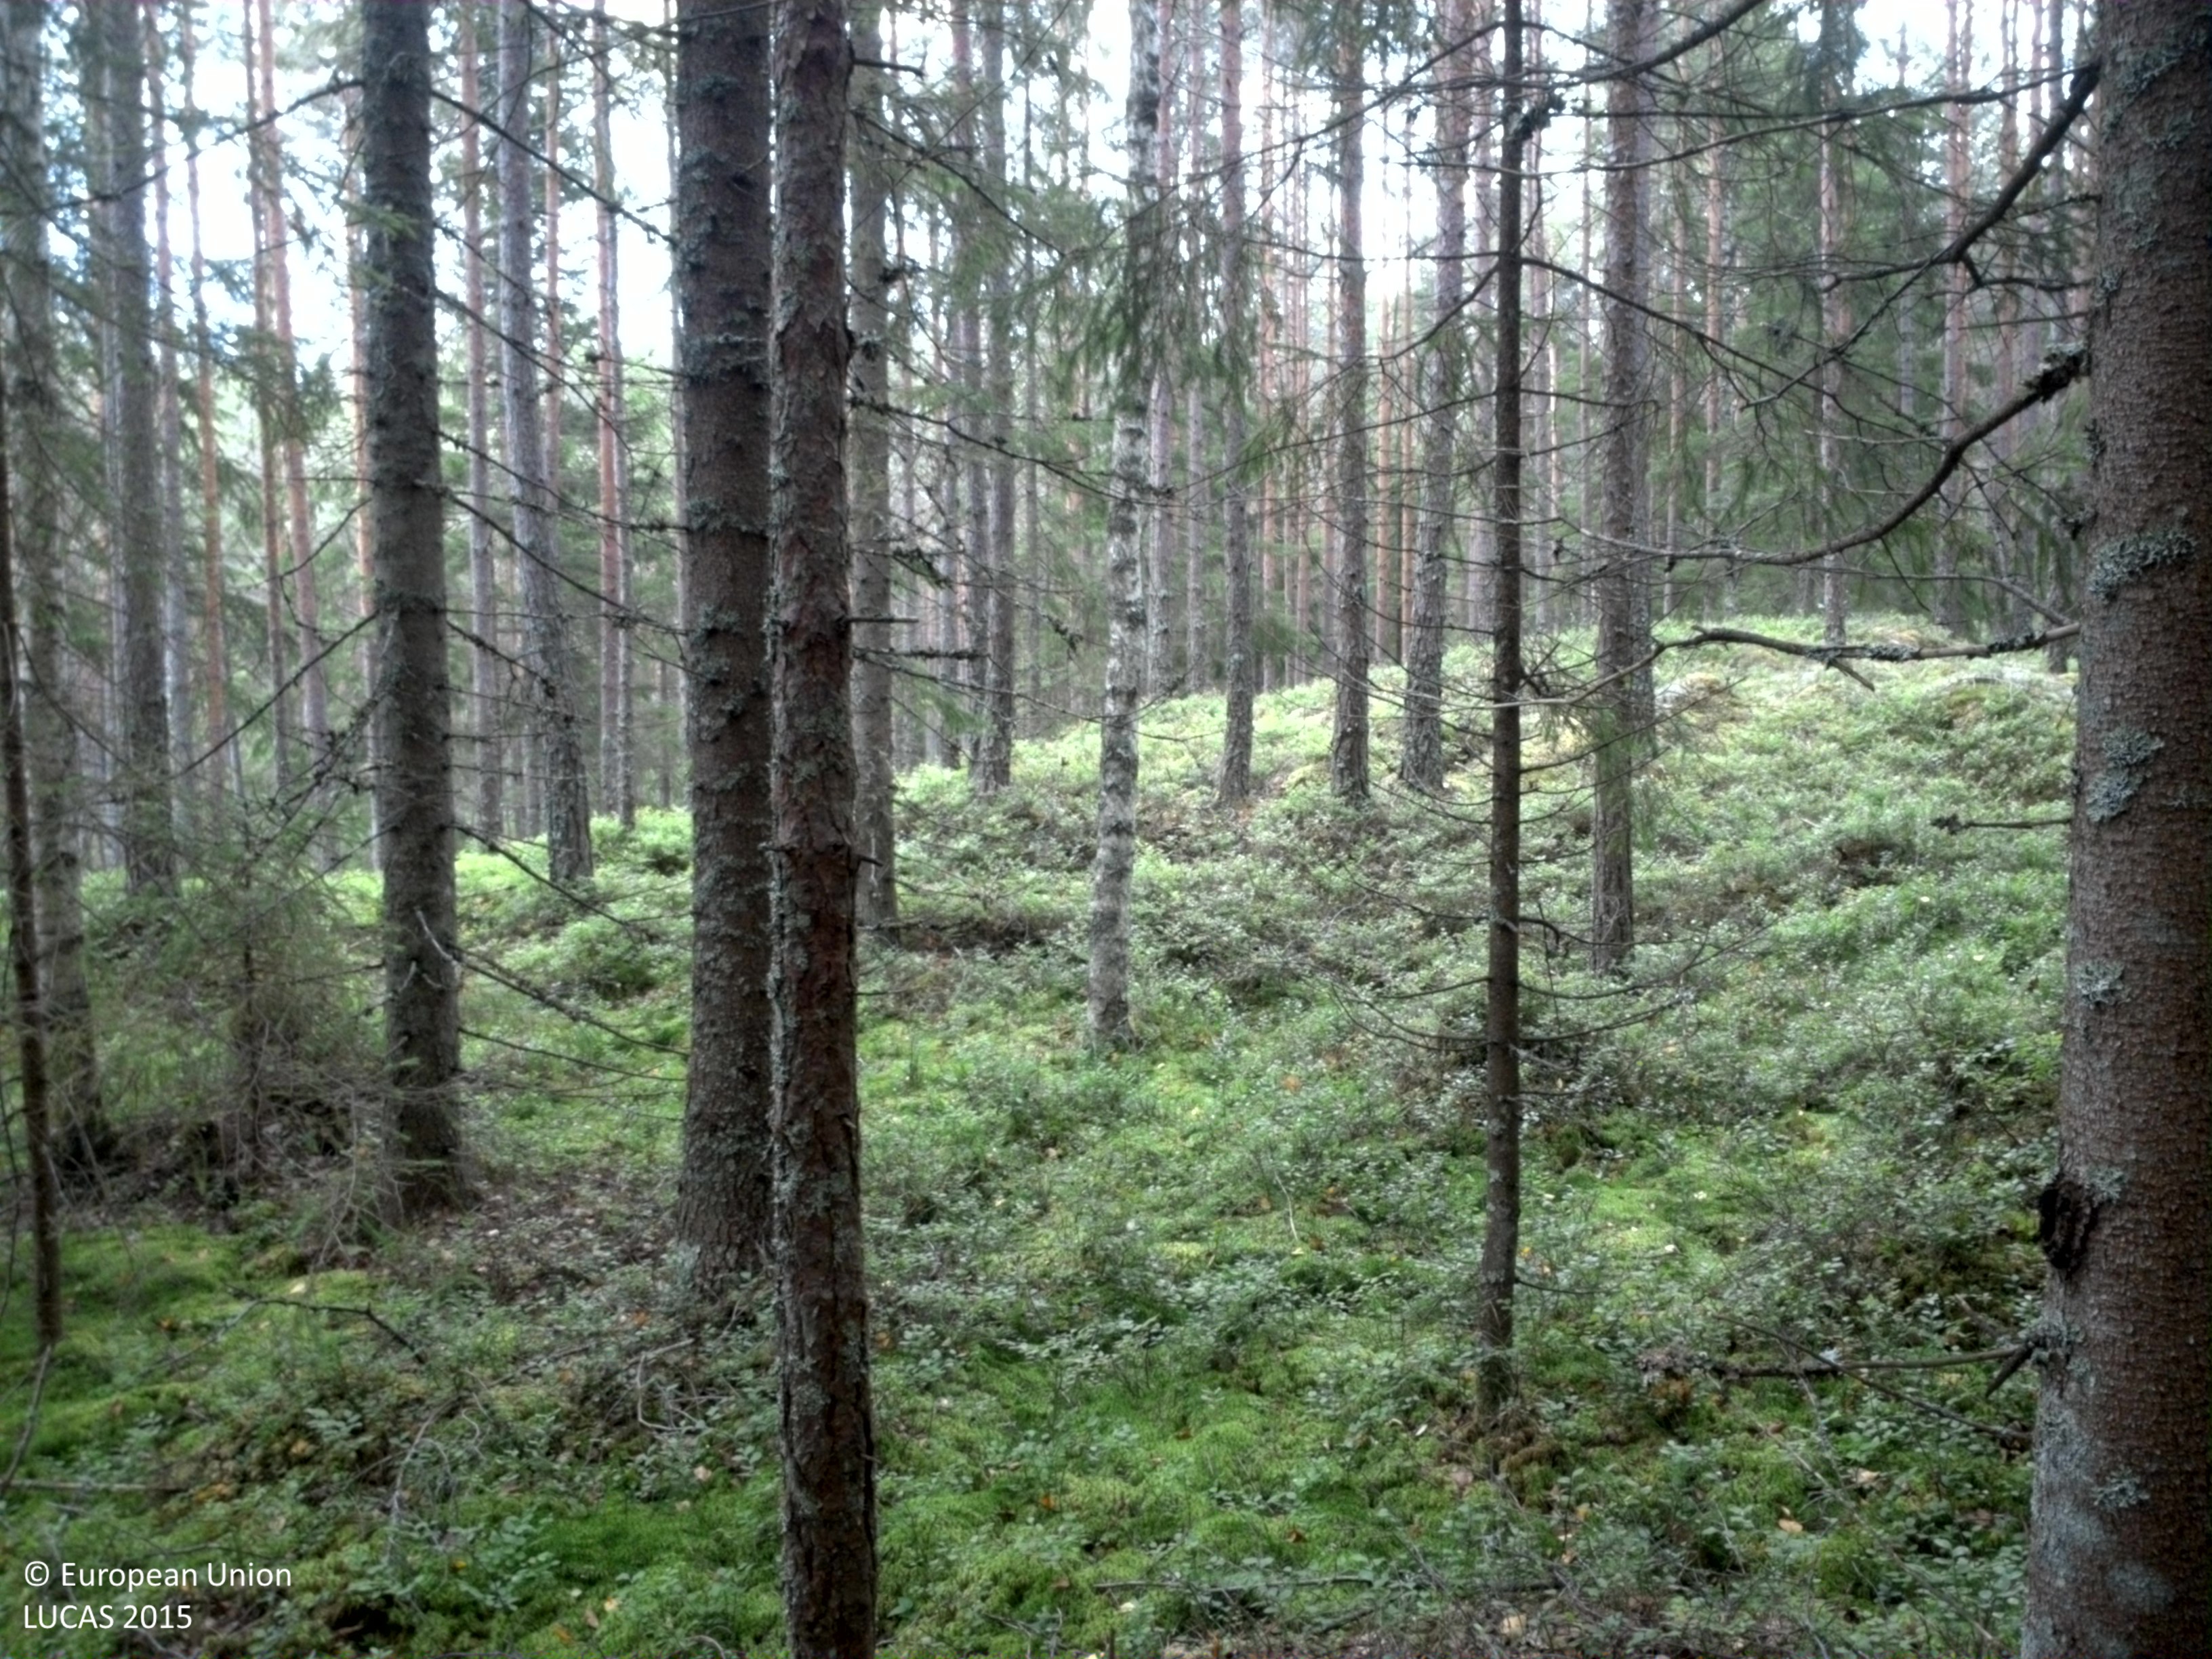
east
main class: Woodland
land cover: Spruce dominated coniferous woodland
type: boreal forest
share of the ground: 50 - 75 %
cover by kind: coniferous forest trees 65 %, lichens and mosses 20 %, shrubs 10 %, broadleaved forest trees 5 %
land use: Forestry
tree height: > 5 m
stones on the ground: < 10 %
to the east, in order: Spruce dominated coniferous woodland; Pine dominated coniferous woodland
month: August
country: SE
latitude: 59.2501
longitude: 11.8715
